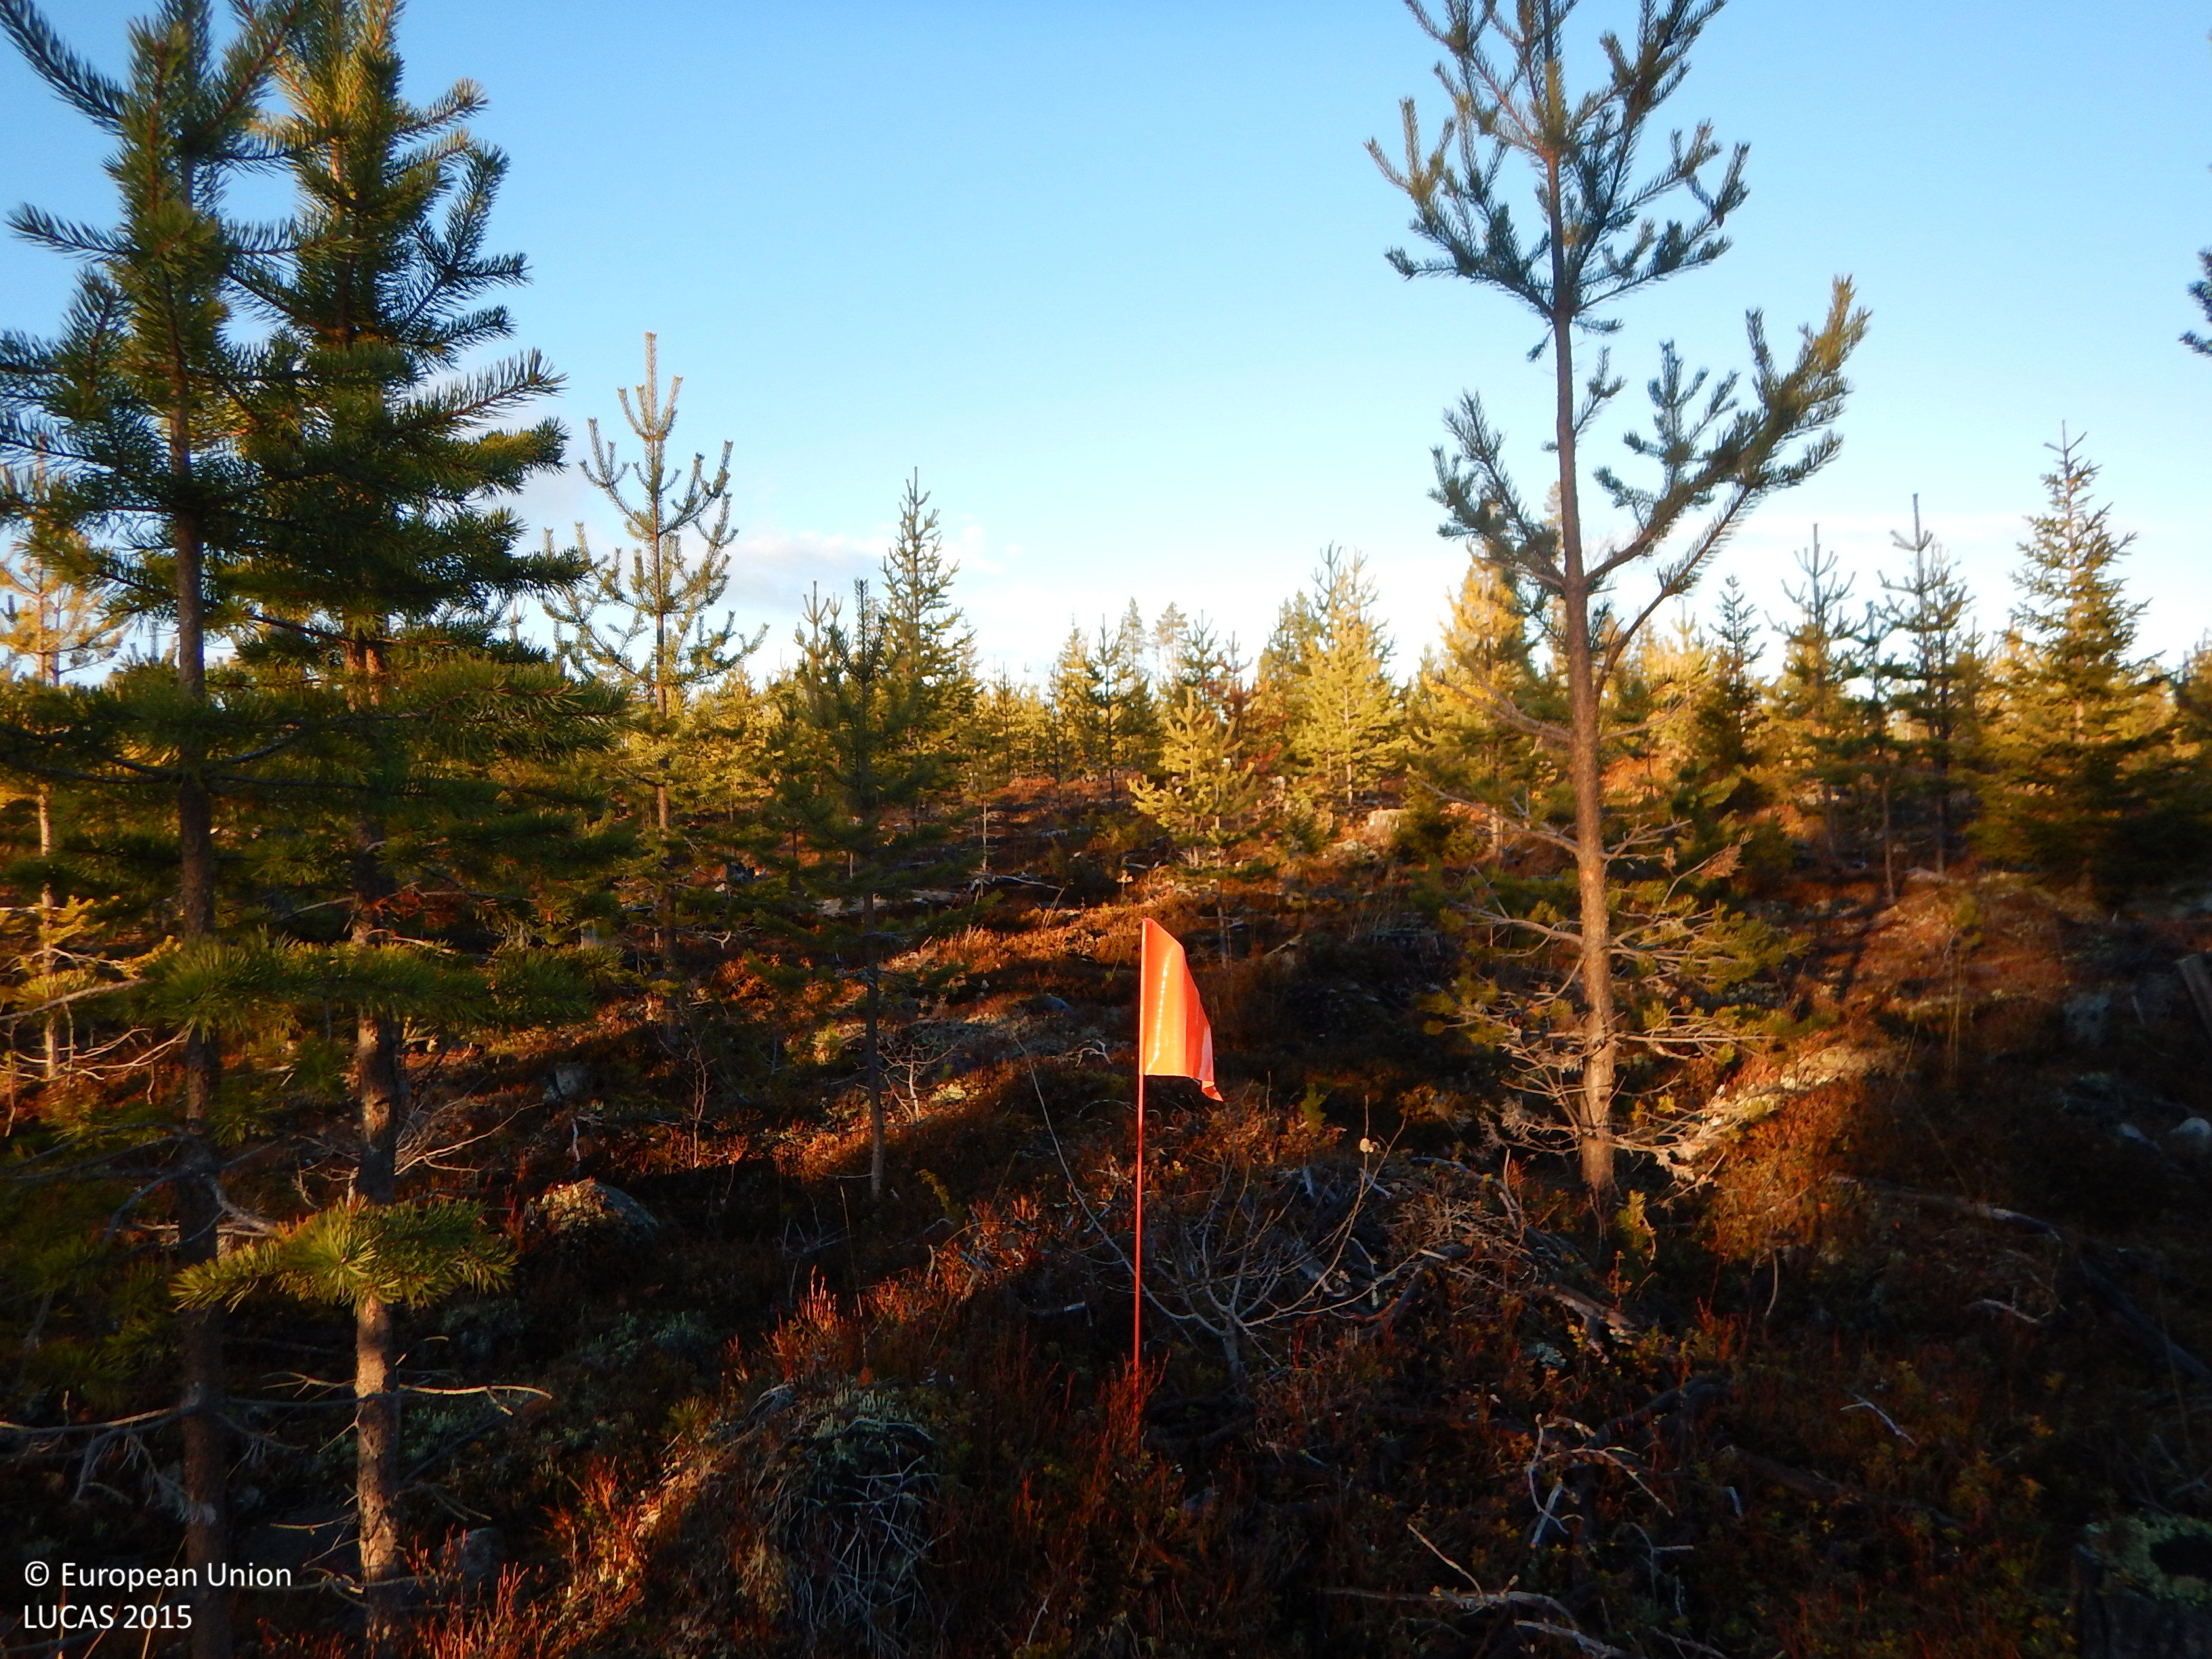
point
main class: Woodland
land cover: Pine dominated coniferous woodland
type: boreal forest
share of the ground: 50 - 75 %
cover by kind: coniferous forest trees 50 %, shrubs 25 %, lichens and mosses 20 %, broadleaved forest trees 5 %
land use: Forestry
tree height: < 5 m
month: November
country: SE
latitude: 65.3718
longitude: 20.6578
